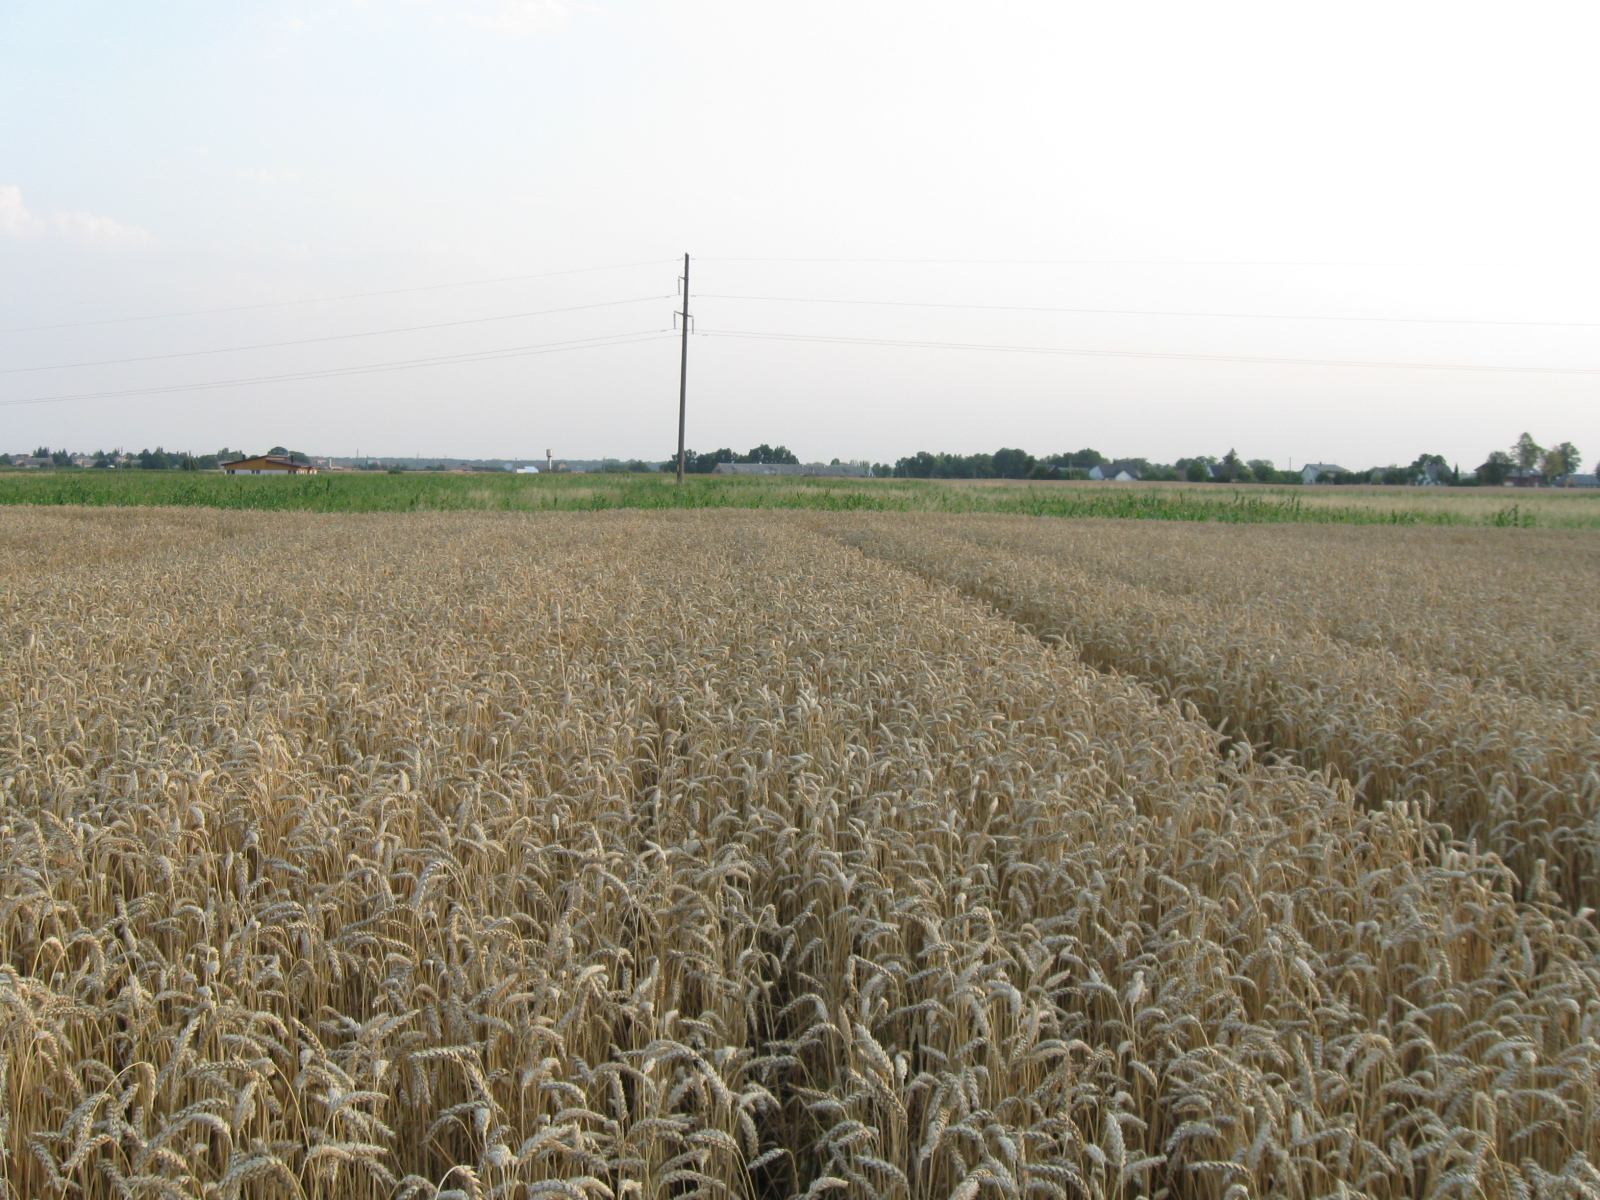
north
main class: Cropland
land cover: Common wheat
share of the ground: > 75 %
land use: Agriculture (excluding fallow land and kitchen gardens)
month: August
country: LT
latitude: 54.5431
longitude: 23.2942
